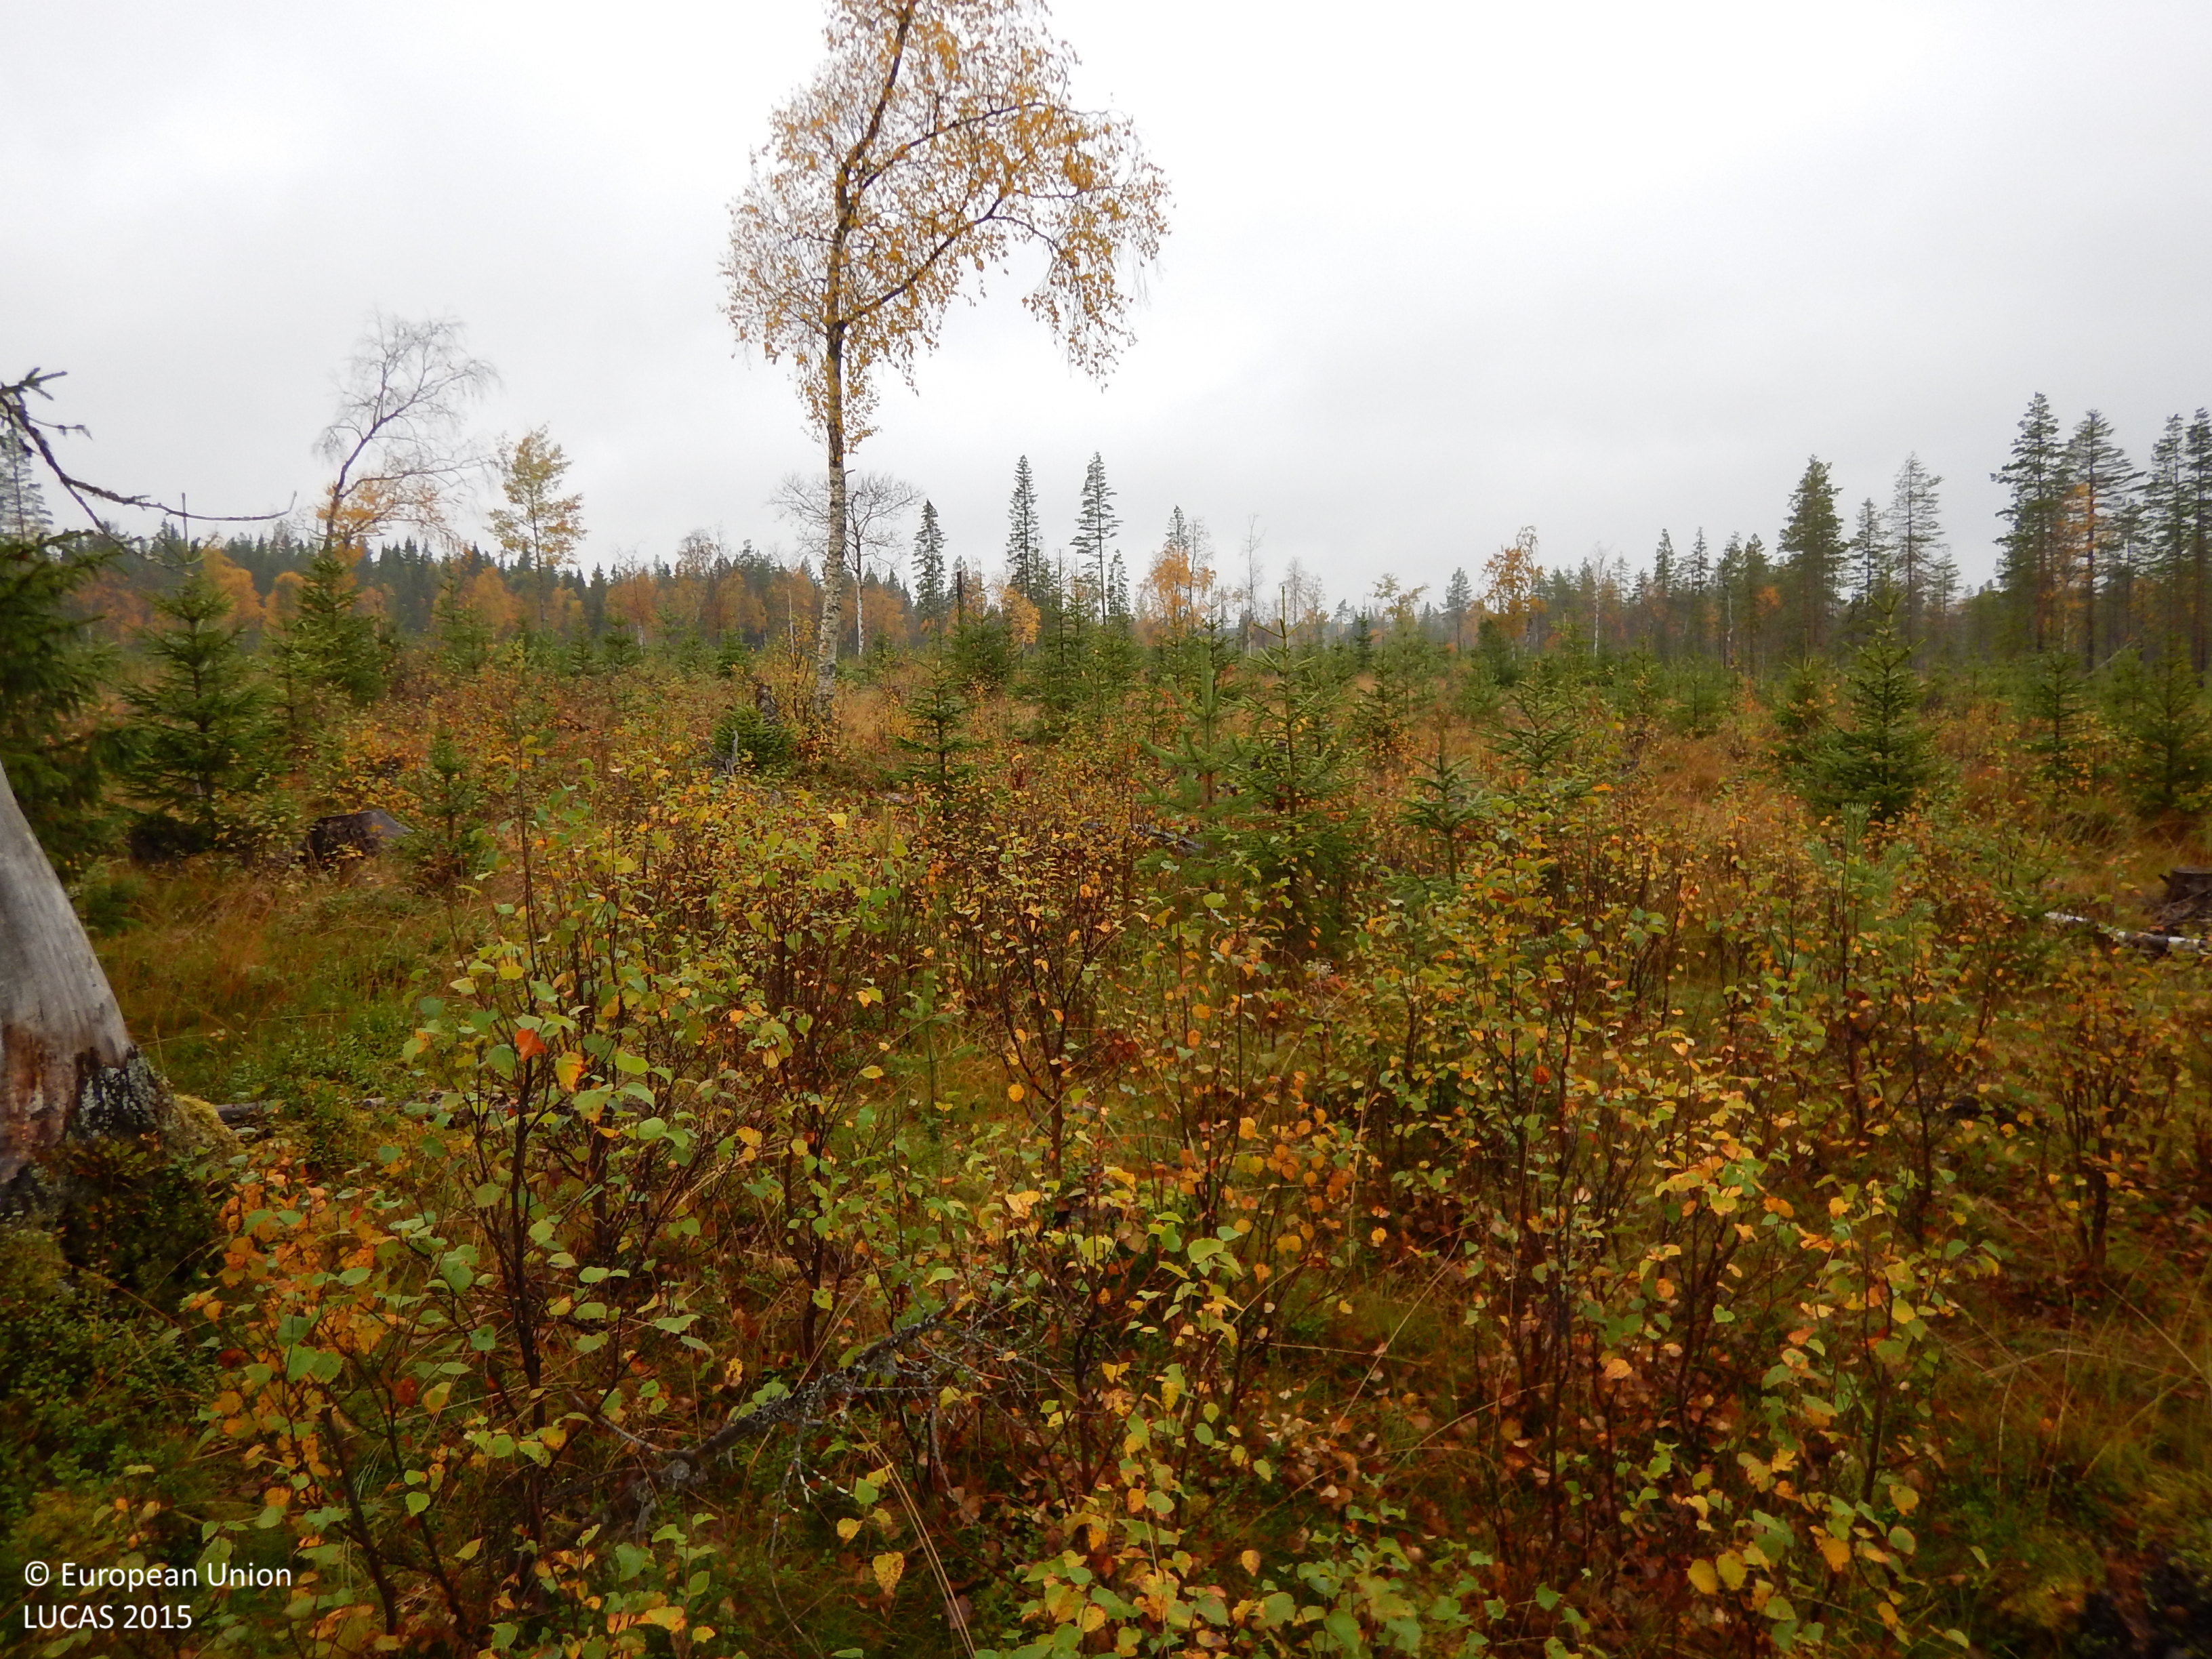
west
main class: Woodland
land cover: Other mixed woodland
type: boreal forest
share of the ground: 50 - 75 %
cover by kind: coniferous forest trees 35 %, broadleaved forest trees 20 %, lichens and mosses 20 %, herbaceous plants 15 %, shrubs 10 %
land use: Forestry
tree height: < 5 m
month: September
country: SE
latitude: 65.0385
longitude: 19.2465
